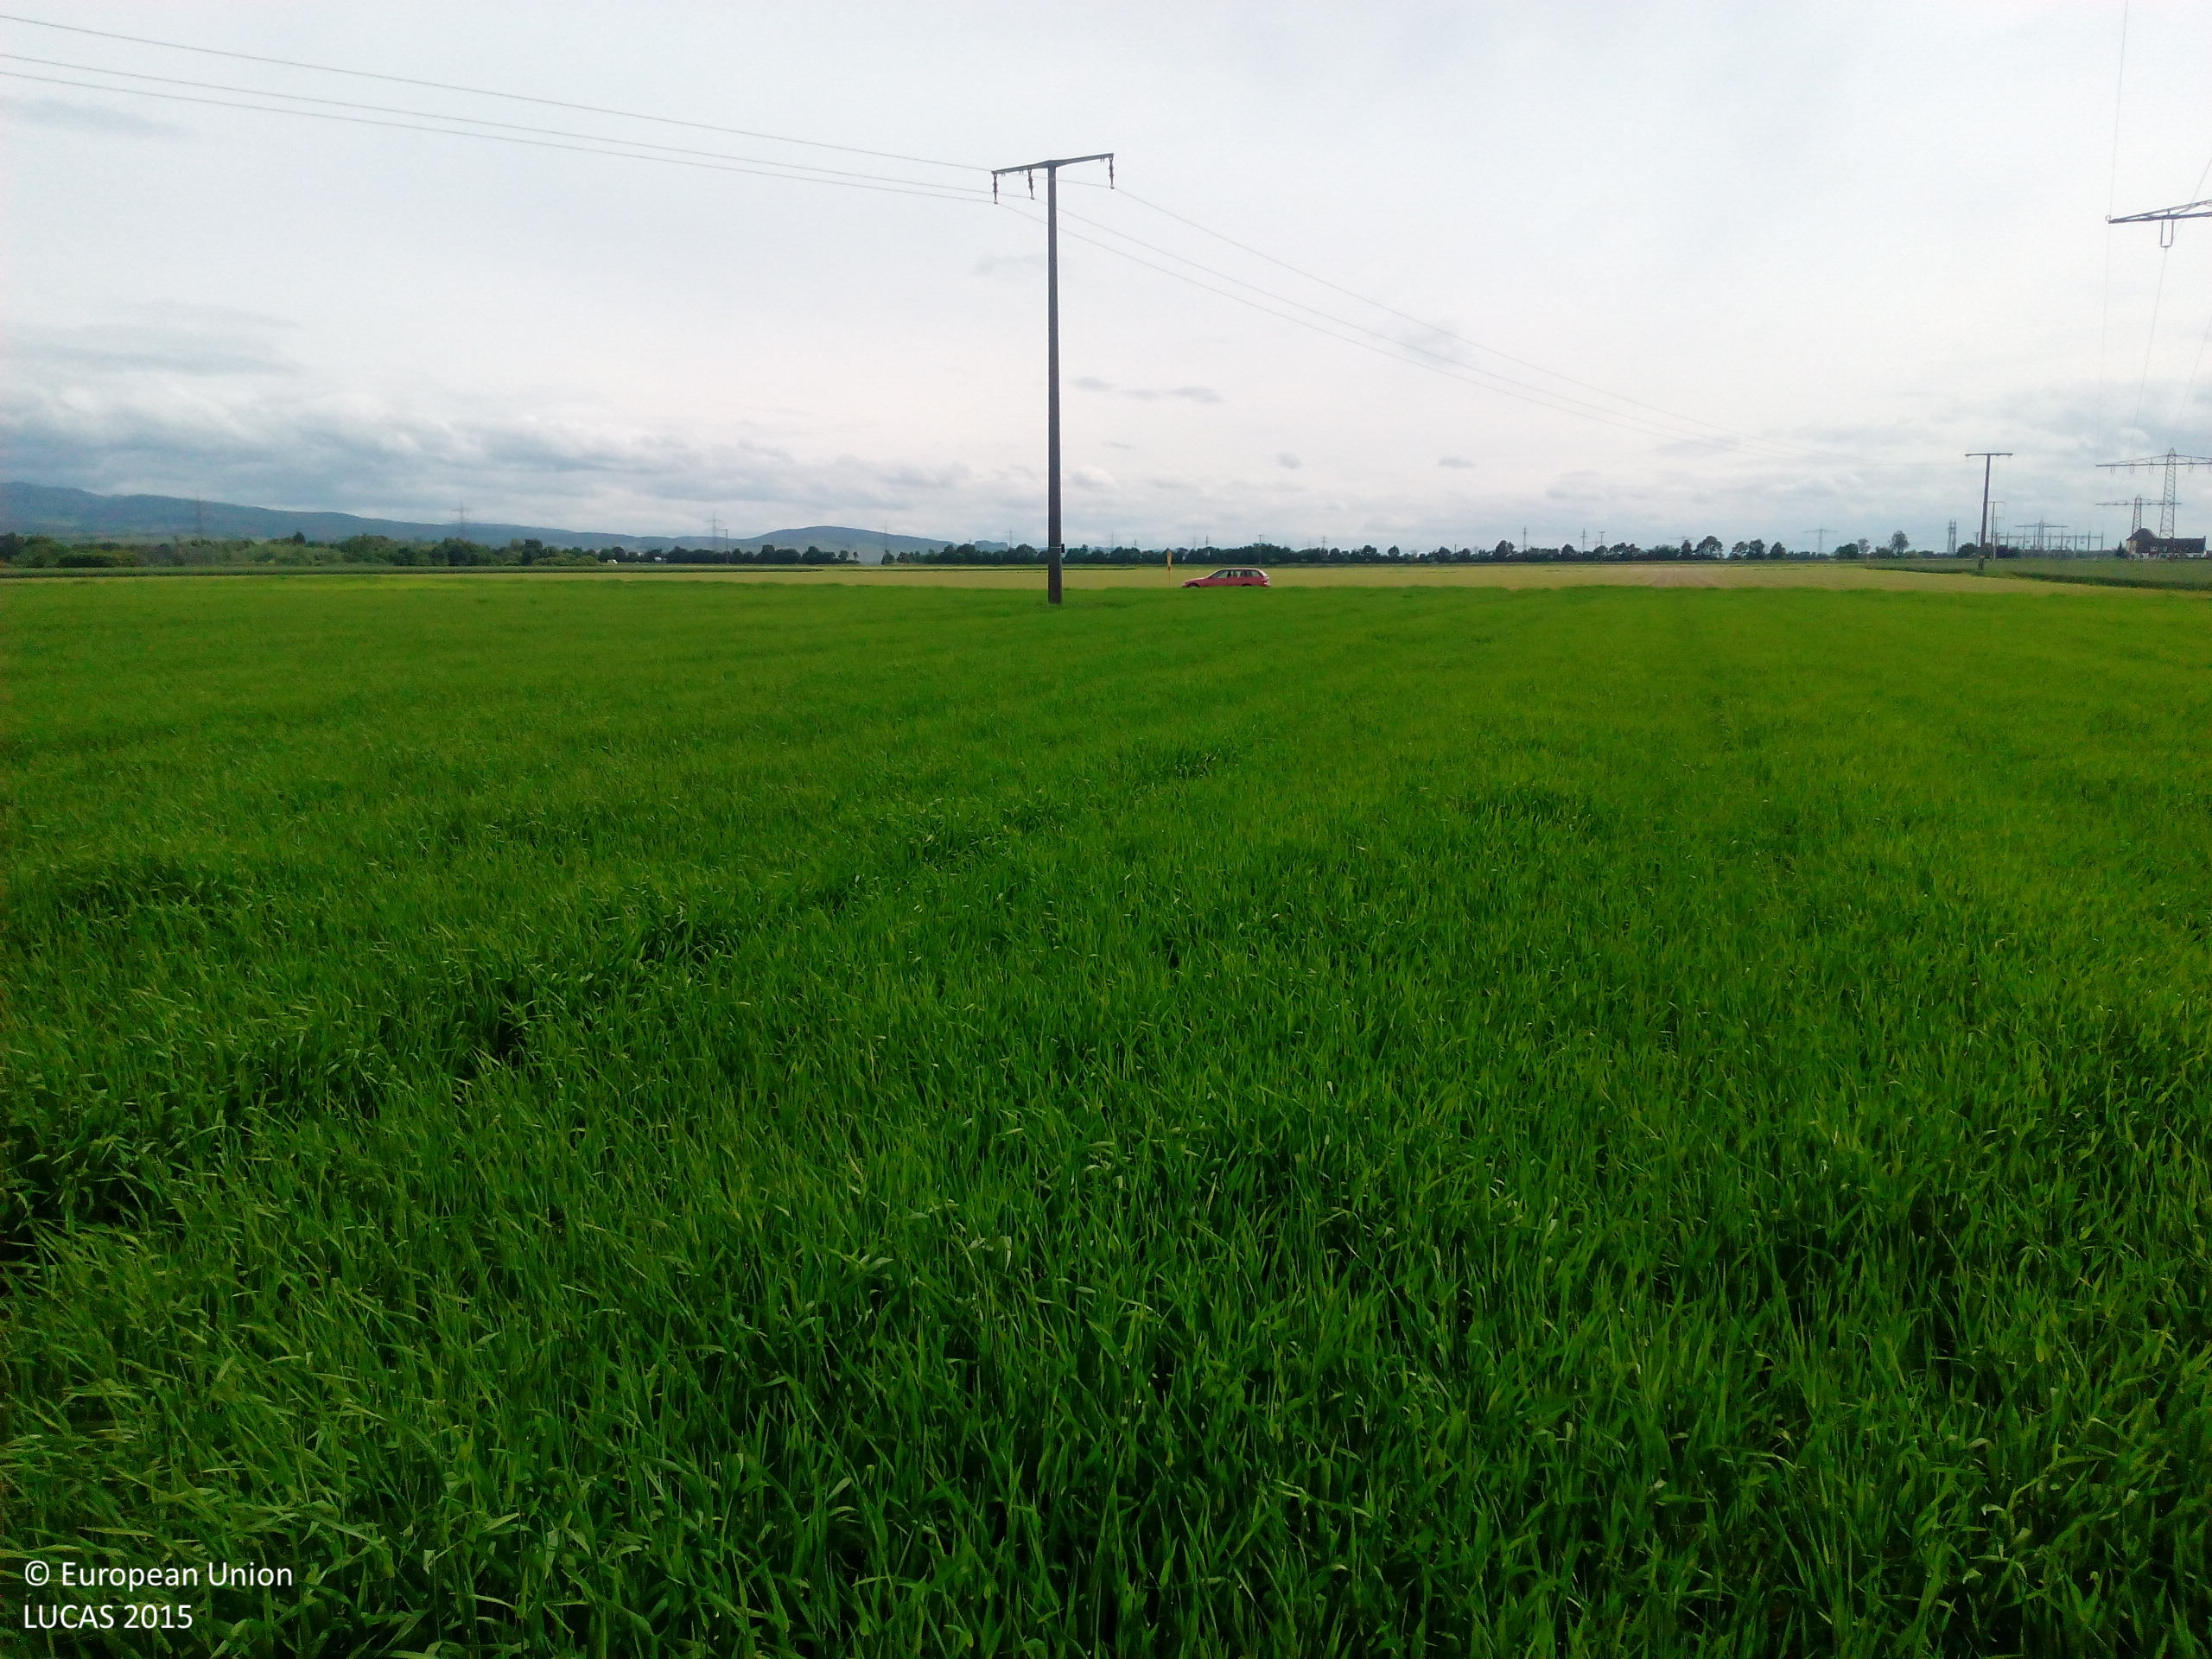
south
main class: Cropland
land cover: Barley
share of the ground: > 75 %
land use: Agriculture (excluding fallow land and kitchen gardens)
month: May
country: DE
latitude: 47.8735
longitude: 7.6081
